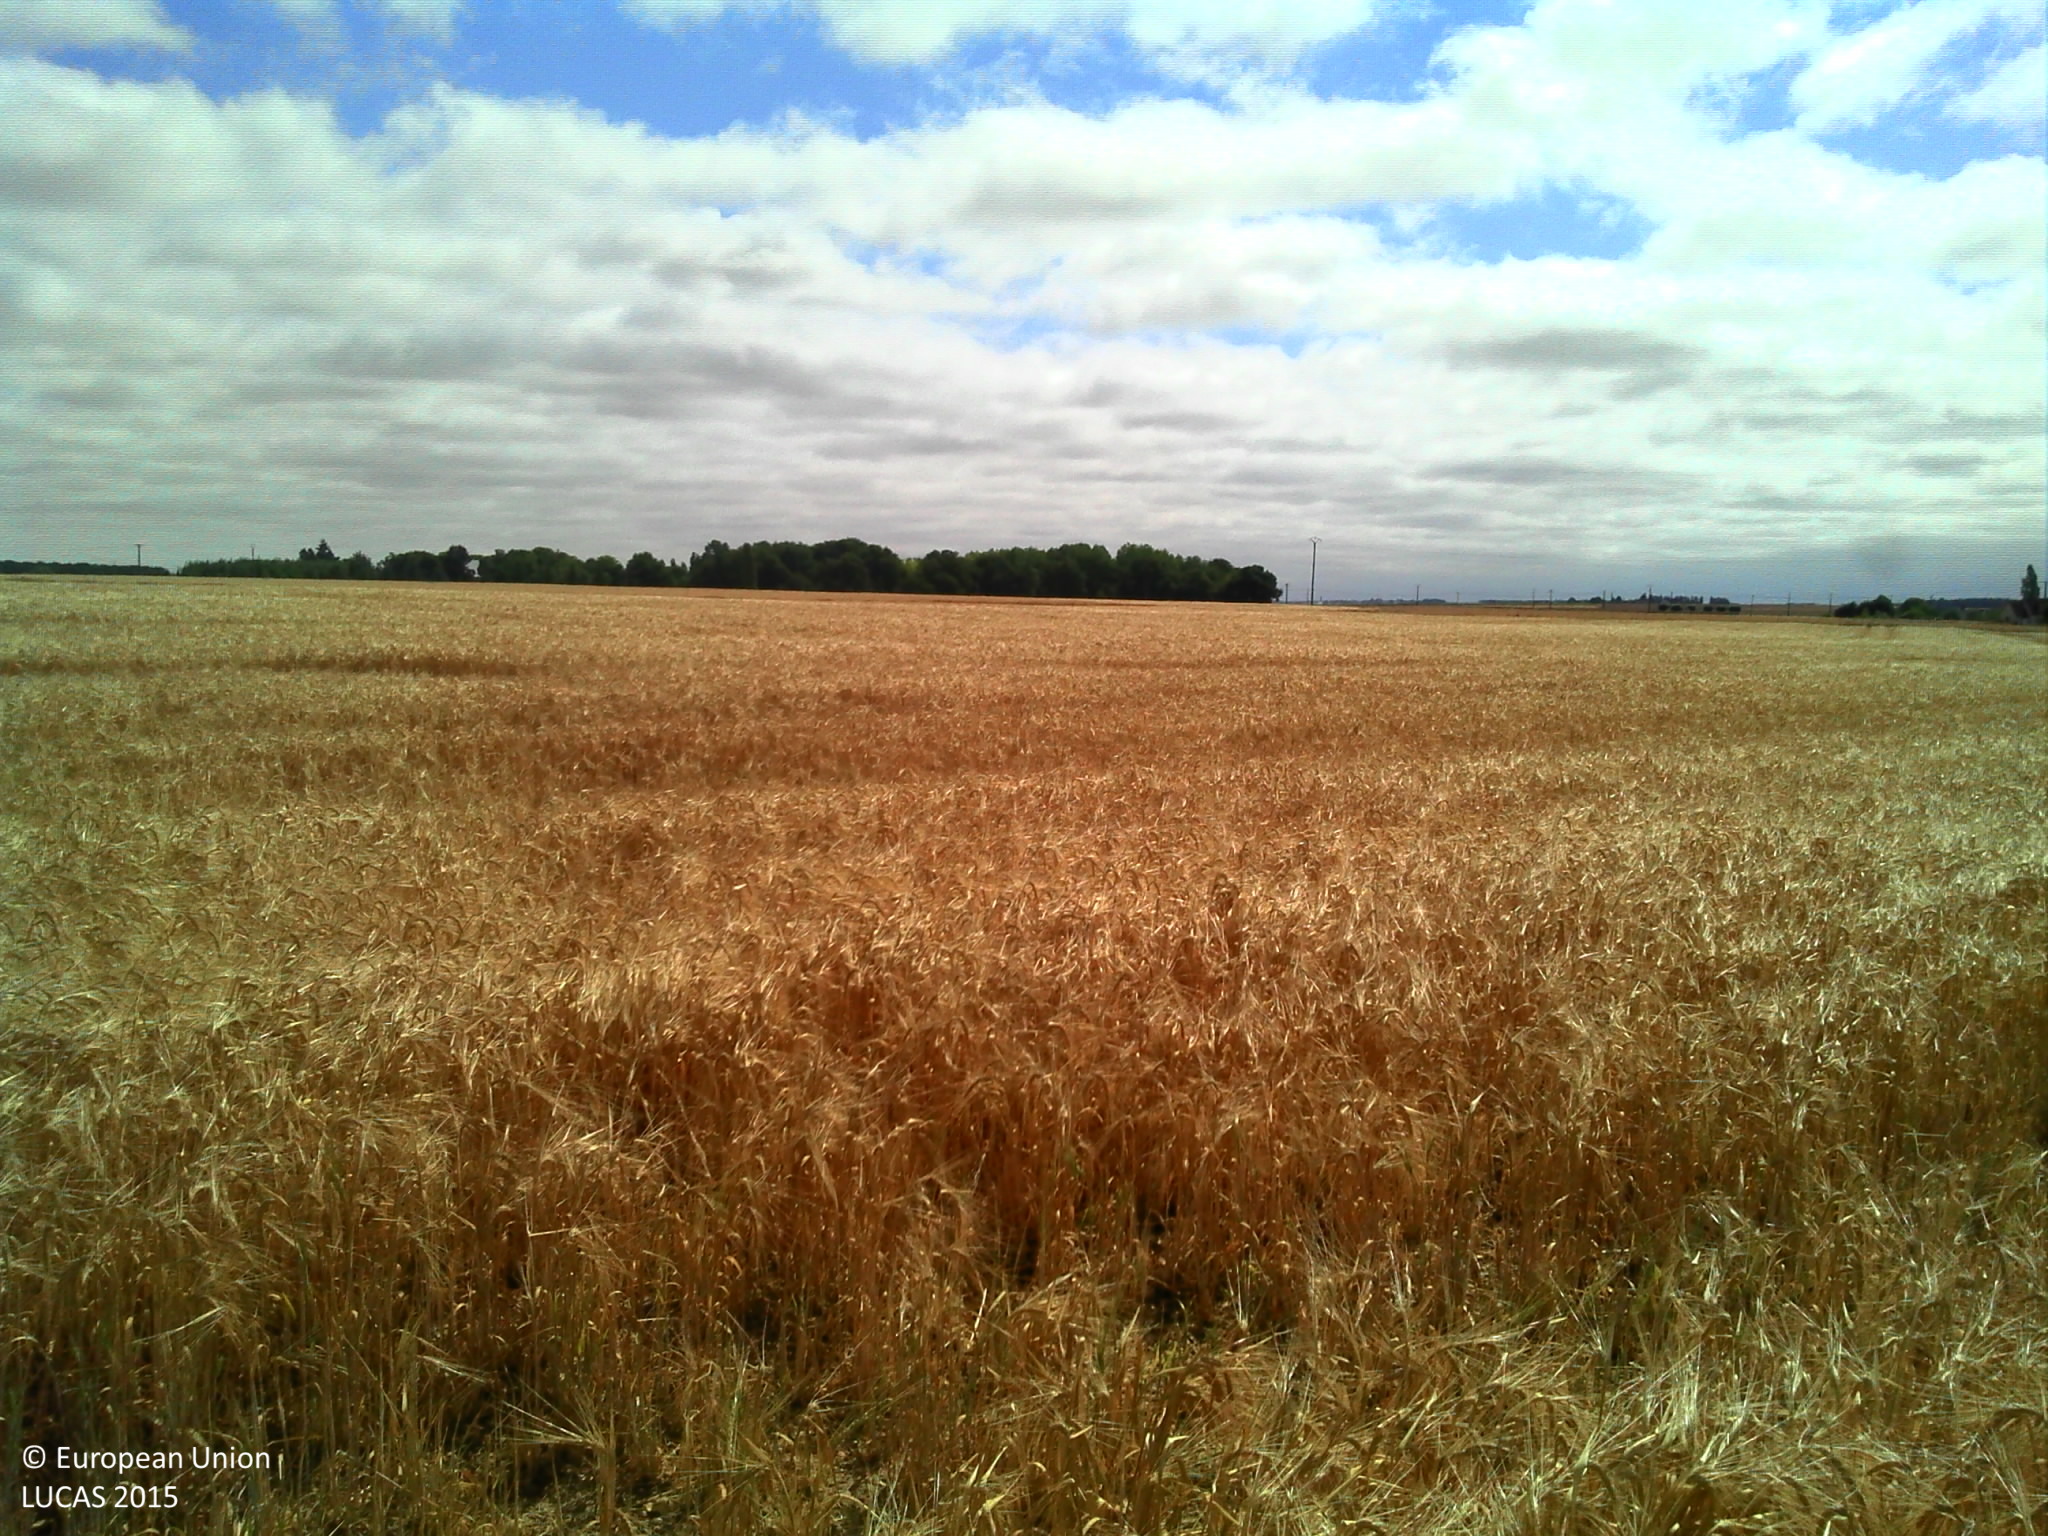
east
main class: Cropland
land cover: Barley
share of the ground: > 75 %
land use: Agriculture (excluding fallow land and kitchen gardens)
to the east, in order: Spontaneously vegetated surfaces; Barley; Common wheat; Barley
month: July
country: FR
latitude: 48.2744
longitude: 1.2643
